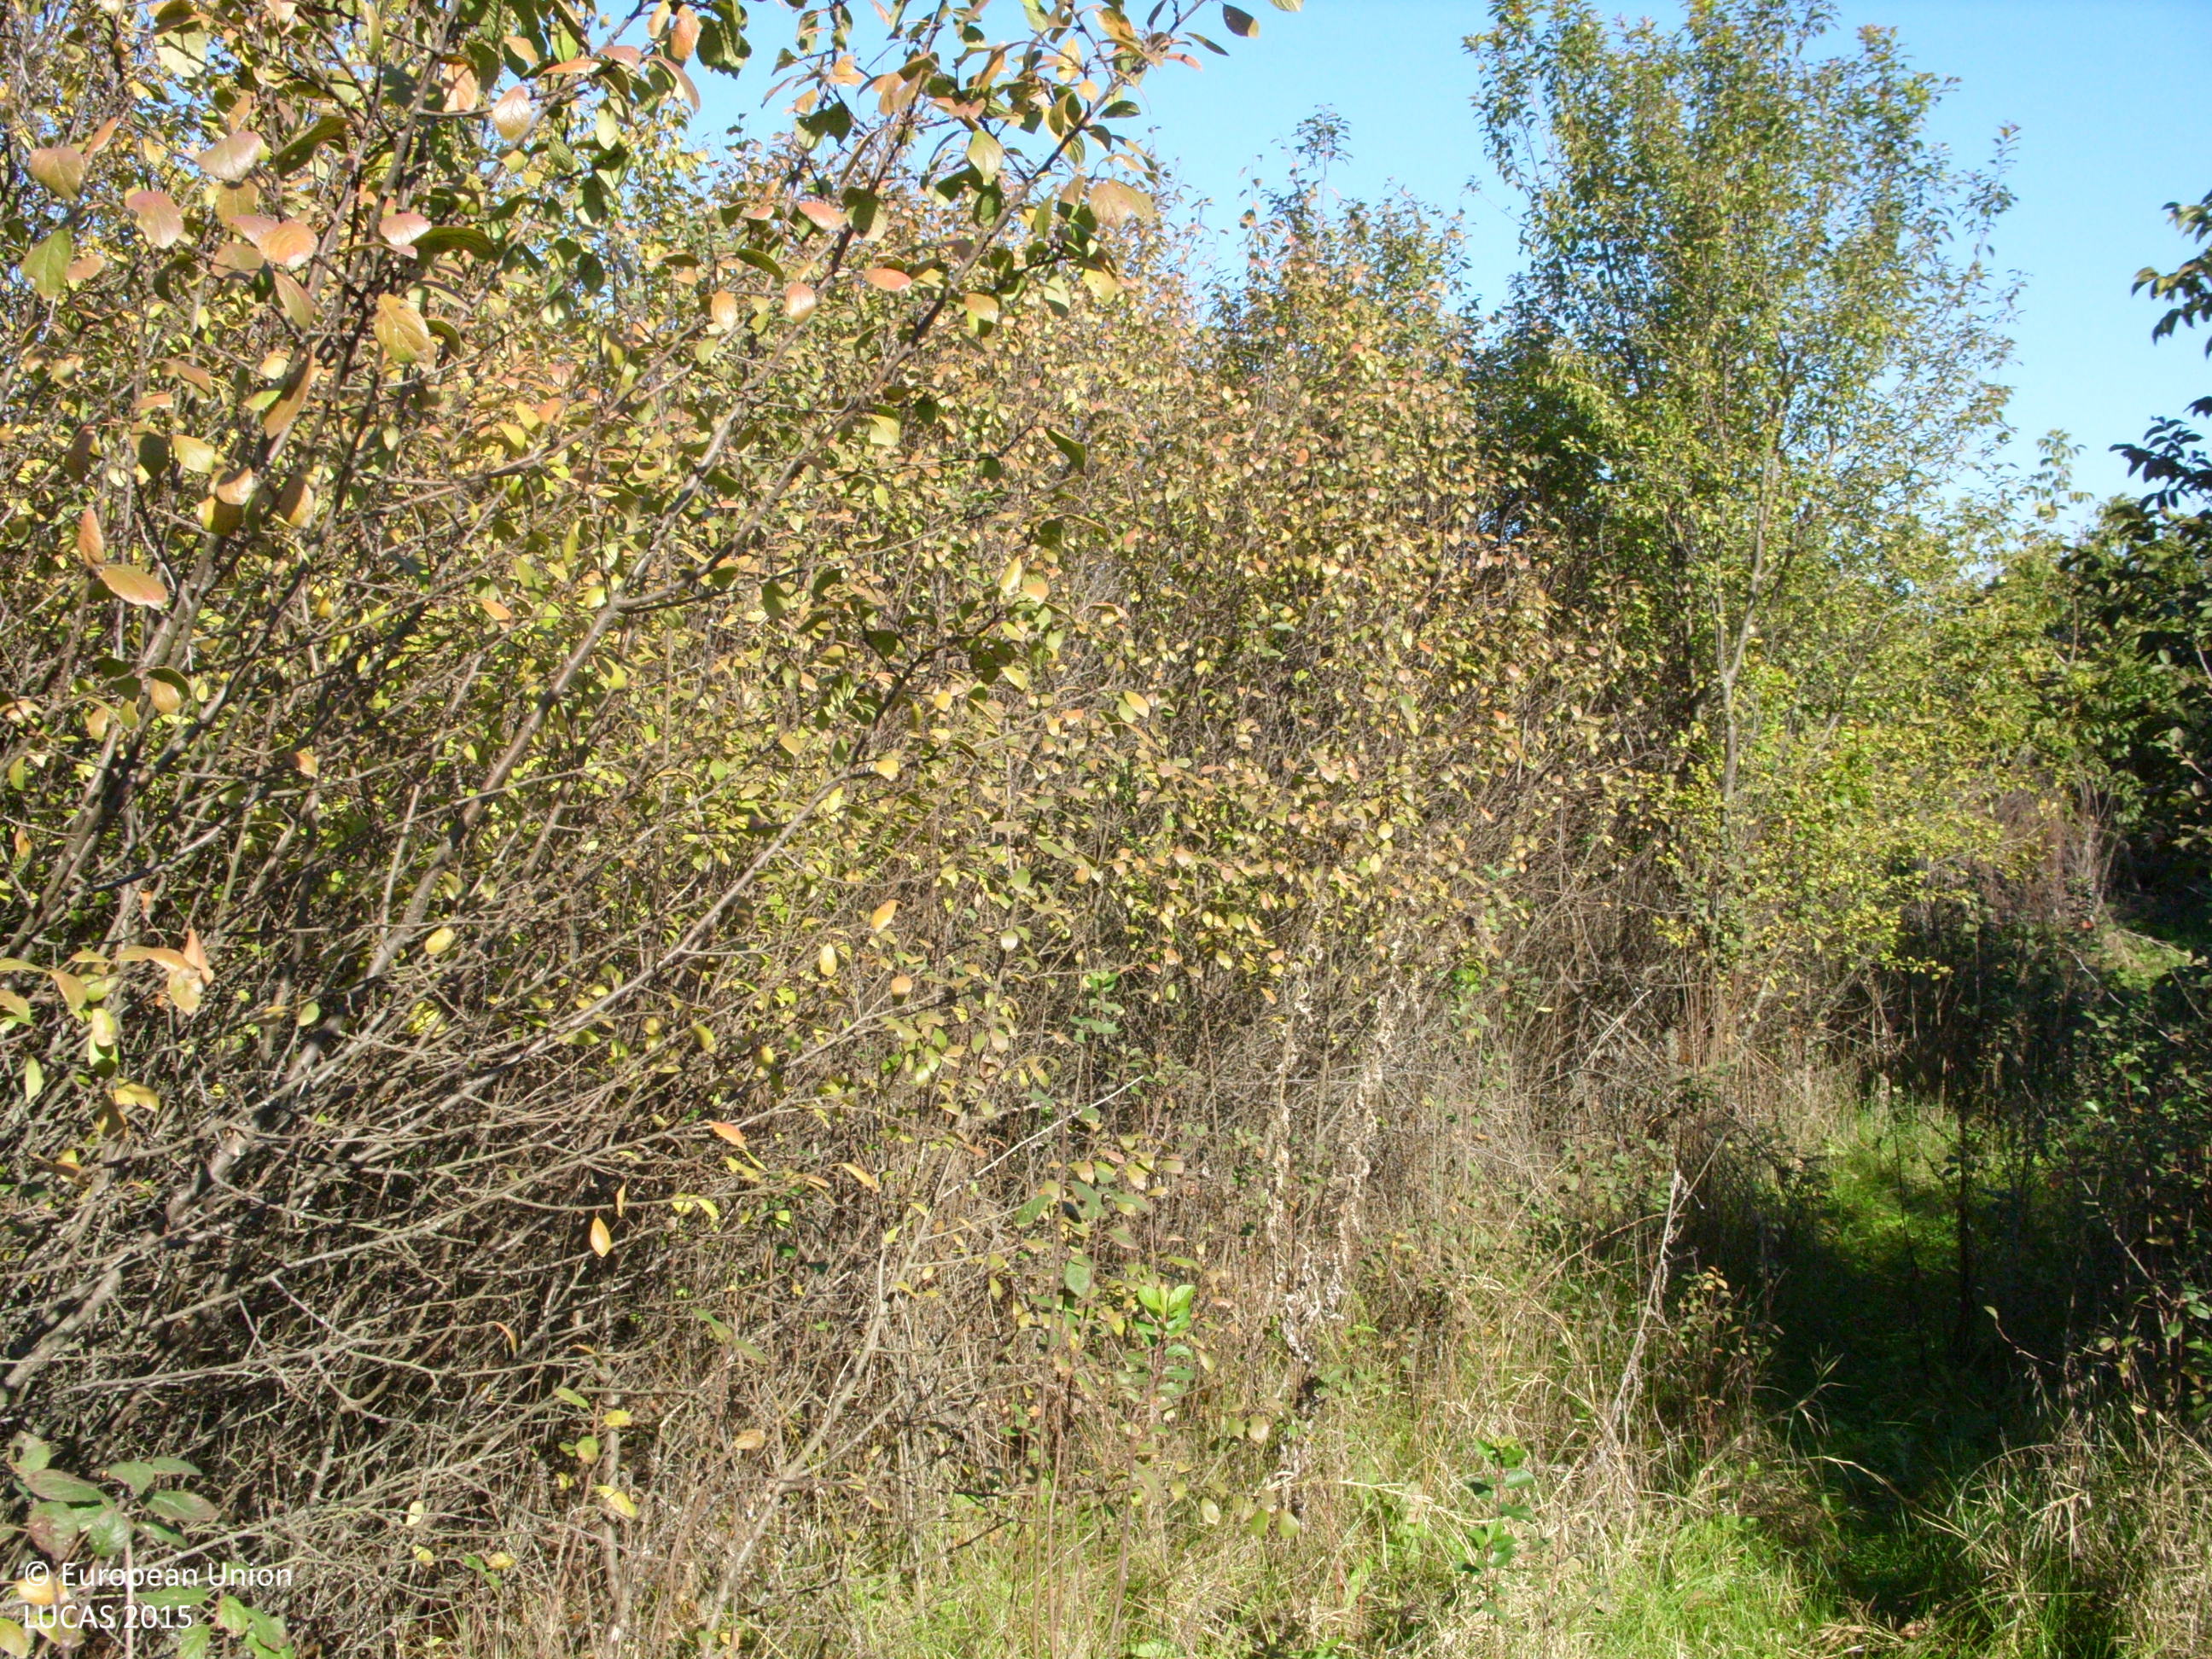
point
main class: Shrubland
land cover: Shrubland with sparse tree cover
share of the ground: > 75 %
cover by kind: shrubs 80 %, herbaceous plants 15 %, broadleaved forest trees 5 %
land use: Abandoned areas
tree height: < 5 m
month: November
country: BG
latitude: 42.3226
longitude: 24.9706
